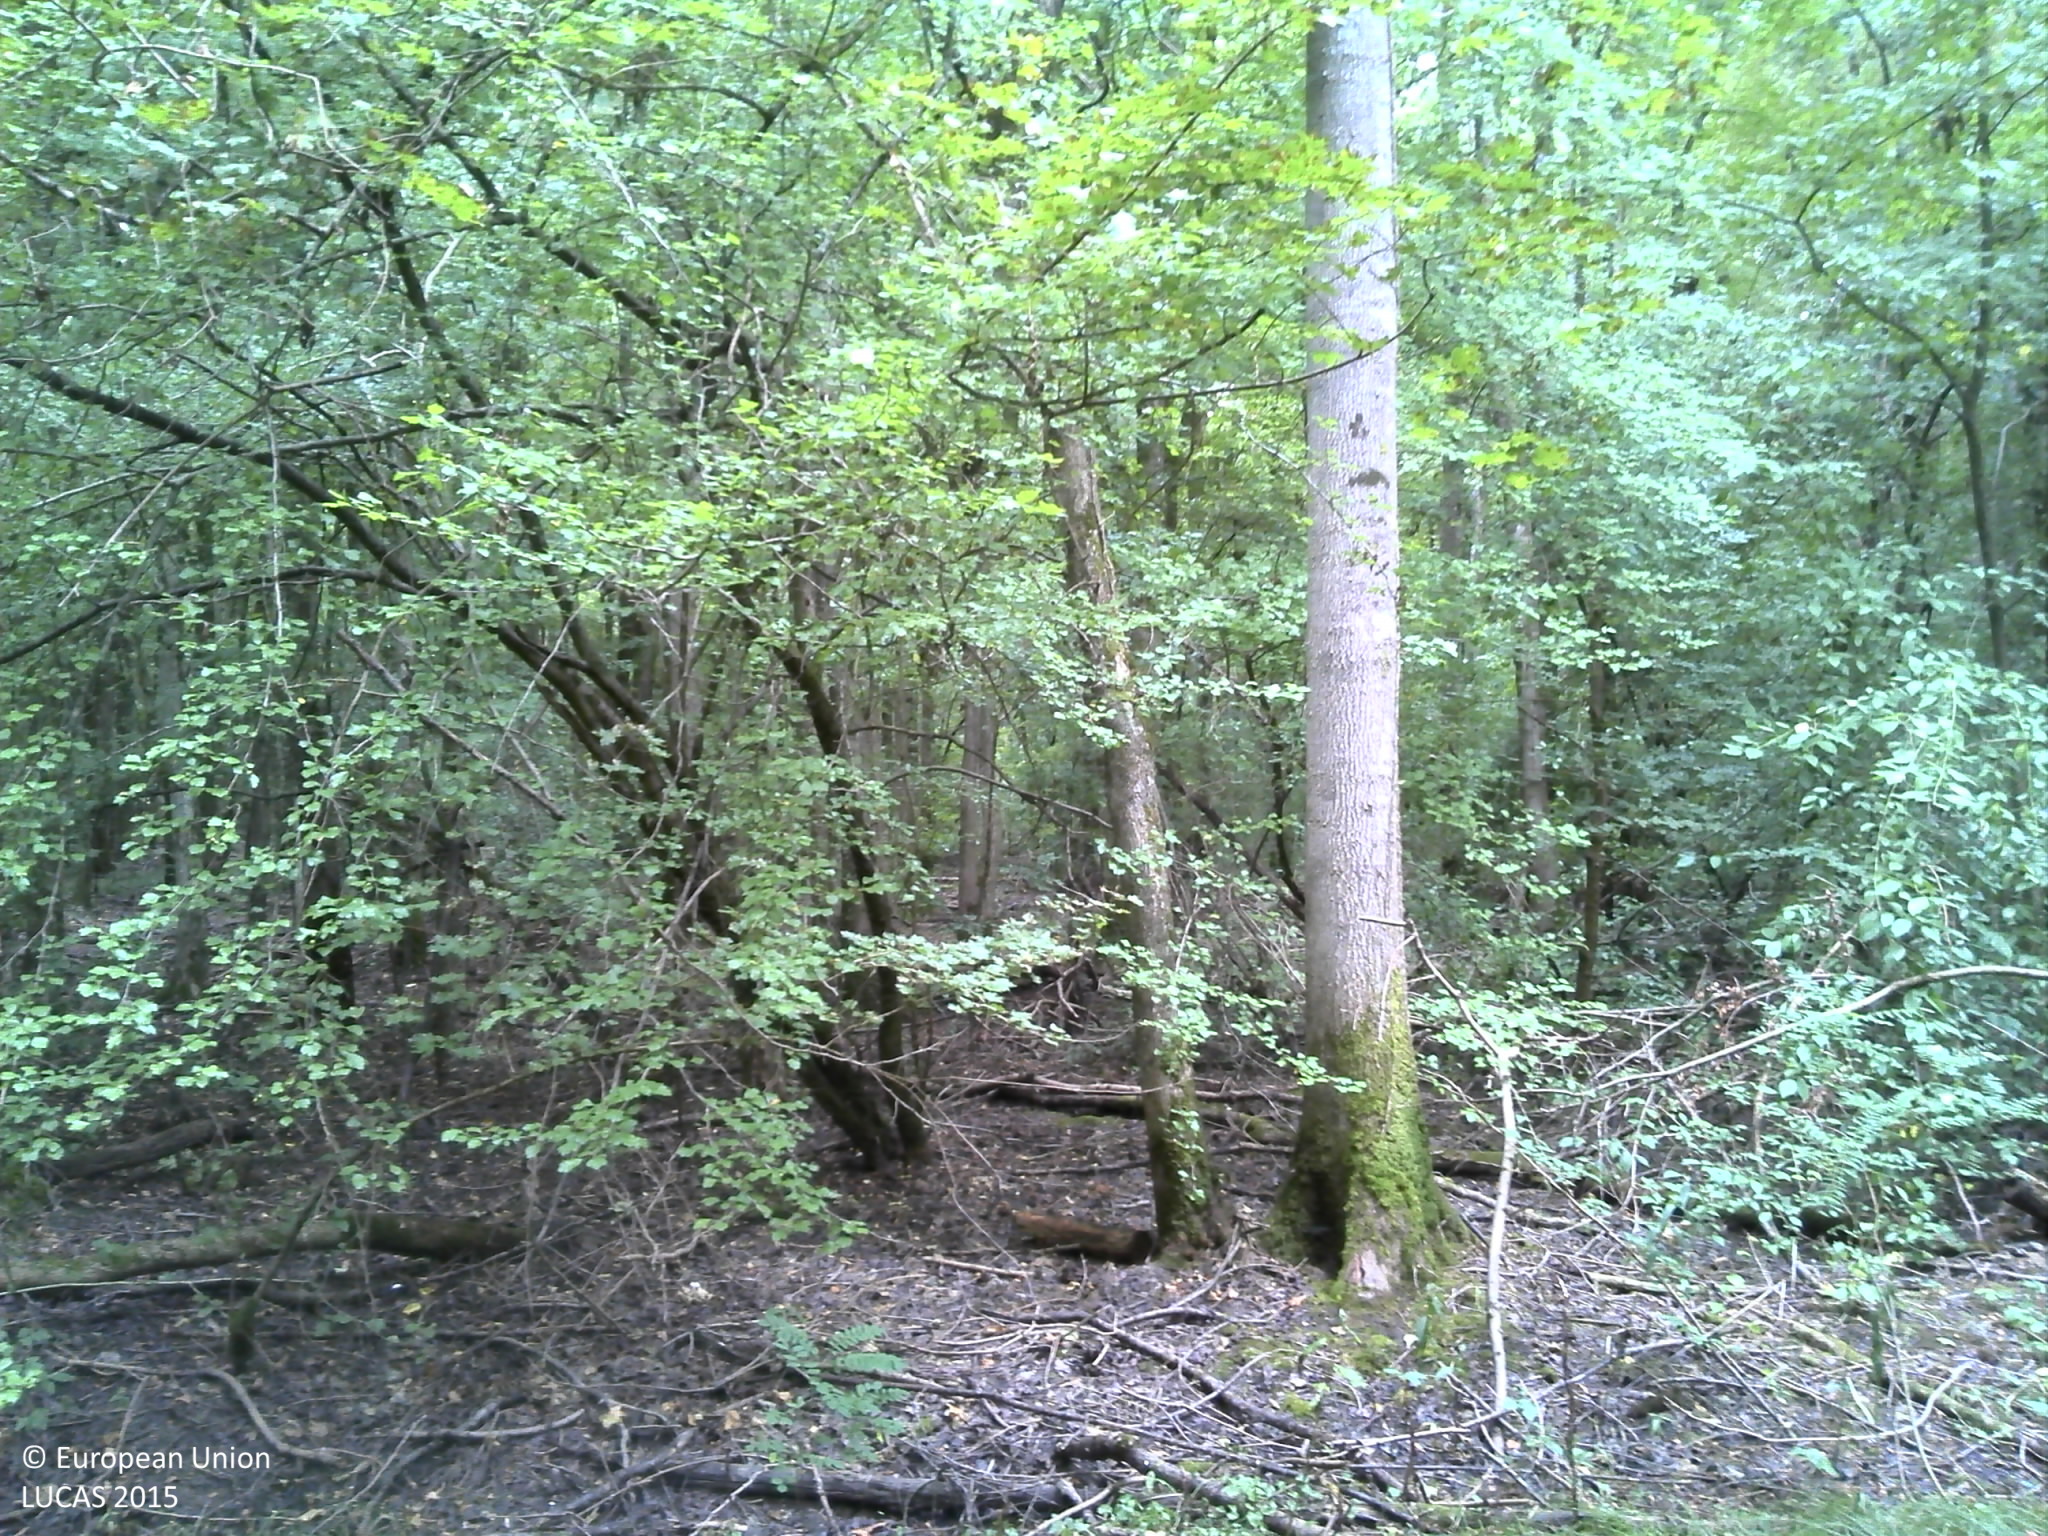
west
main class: Woodland
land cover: Broadleaved woodland
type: mesophytic deciduous forest
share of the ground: > 75 %
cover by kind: broadleaved forest trees 100 %
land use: Forestry
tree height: > 5 m
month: July
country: HR
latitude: 44.9359
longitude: 18.8125
